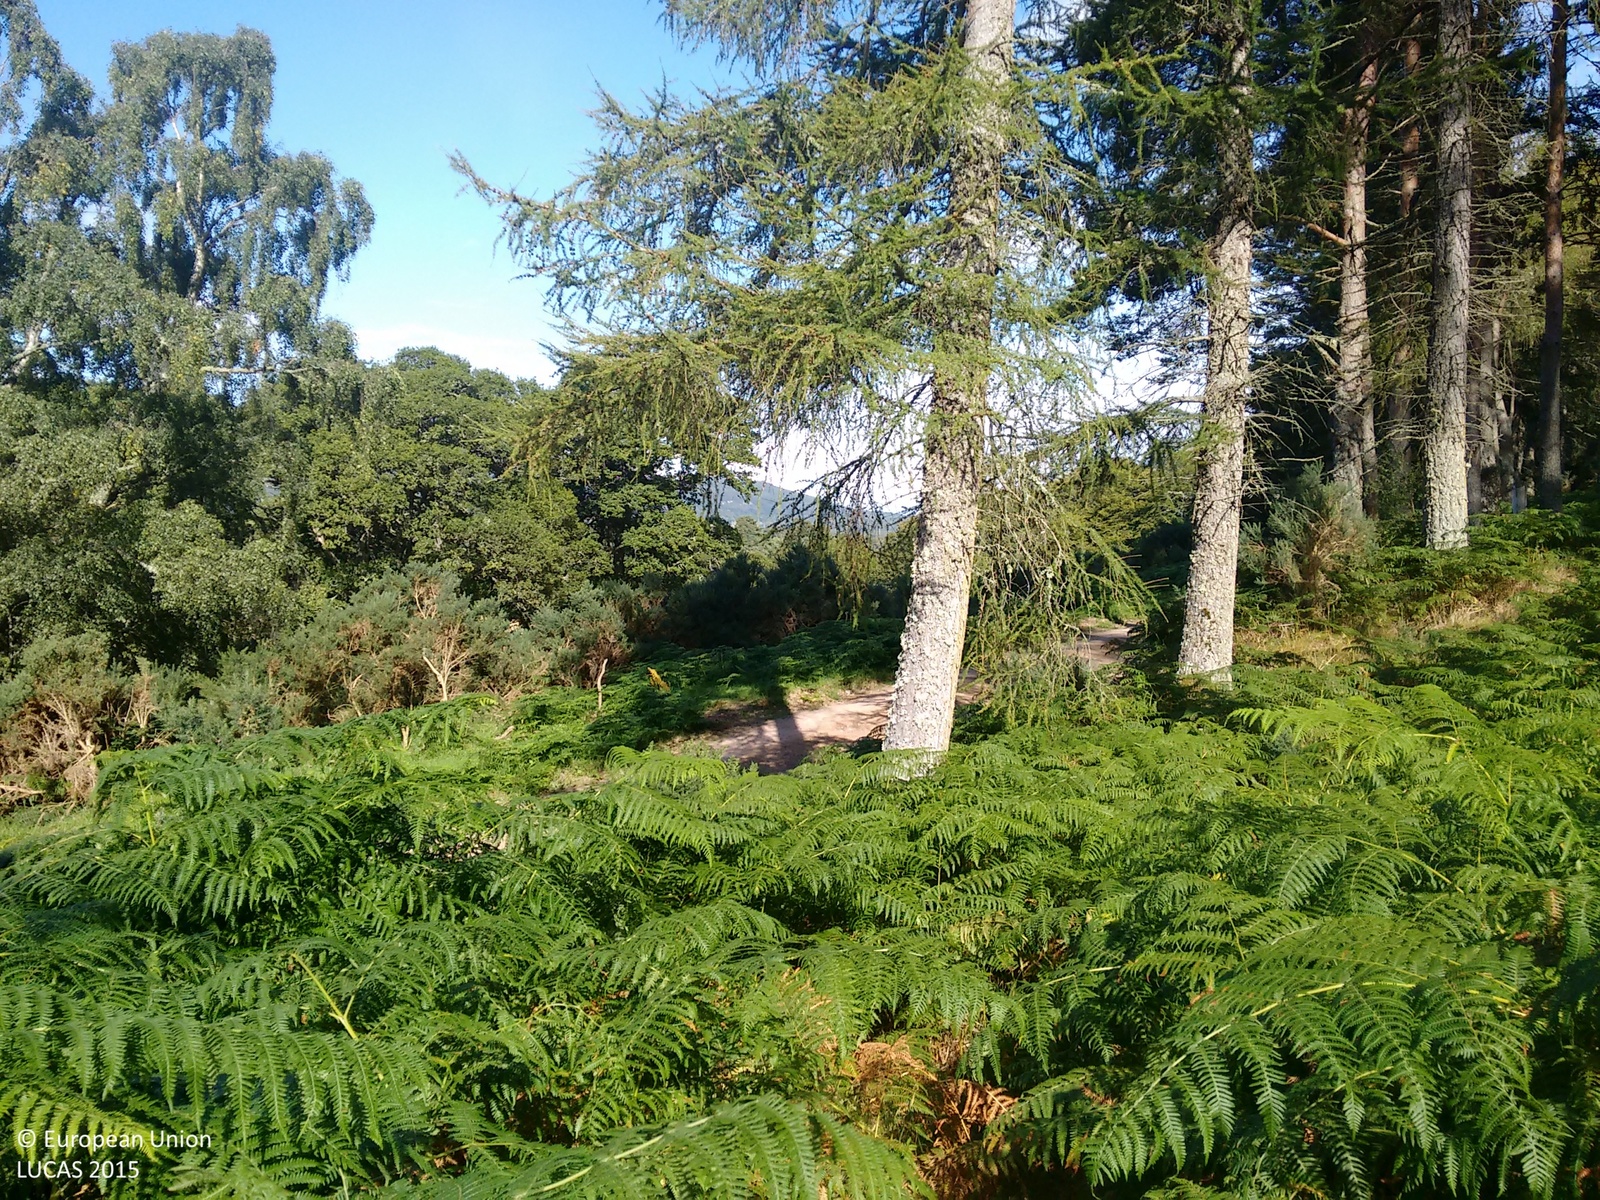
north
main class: Woodland
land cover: Other coniferous woodland
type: exotic forest
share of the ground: > 75 %
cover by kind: herbaceous plants 65 %, coniferous forest trees 30 %, shrubs 5 %
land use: Forestry
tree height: > 5 m
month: September
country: GB
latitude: 57.4139
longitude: -4.2876
